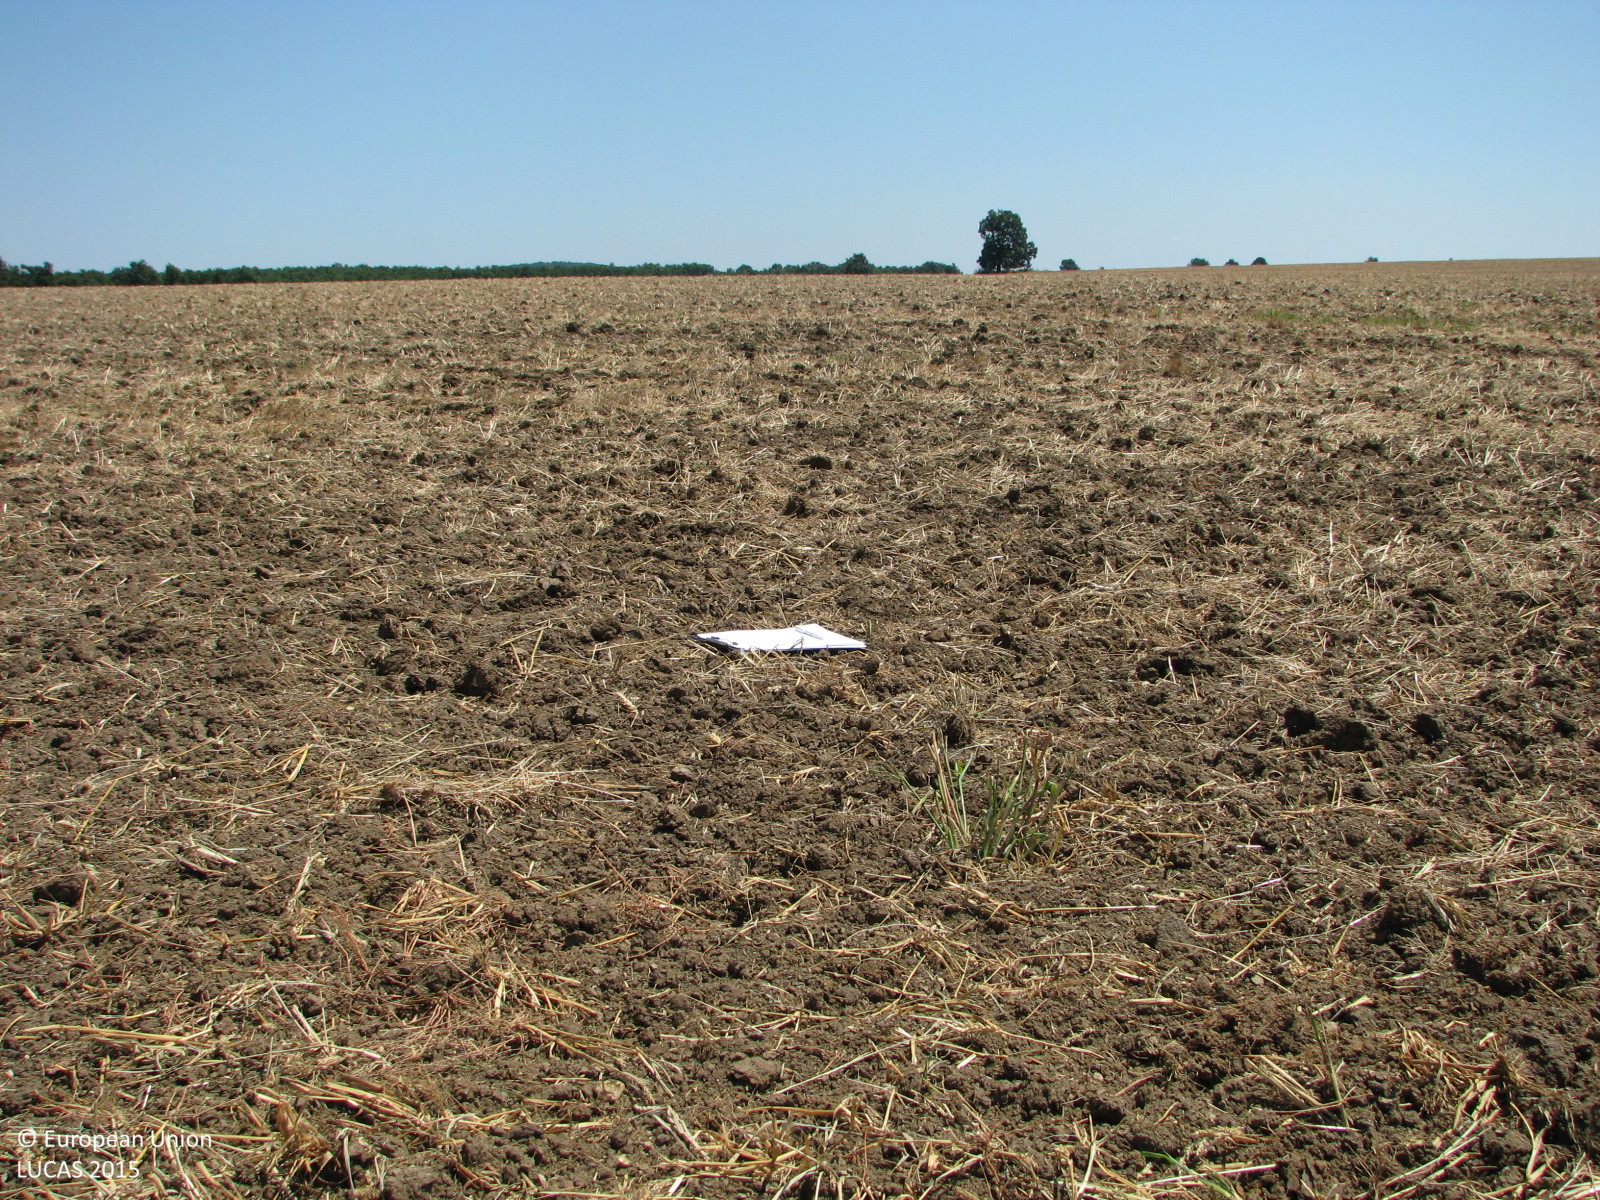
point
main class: Cropland
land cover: Common wheat
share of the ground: < 10 %
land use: Agriculture (excluding fallow land and kitchen gardens)
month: July
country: BG
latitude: 42.2240
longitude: 26.8528
